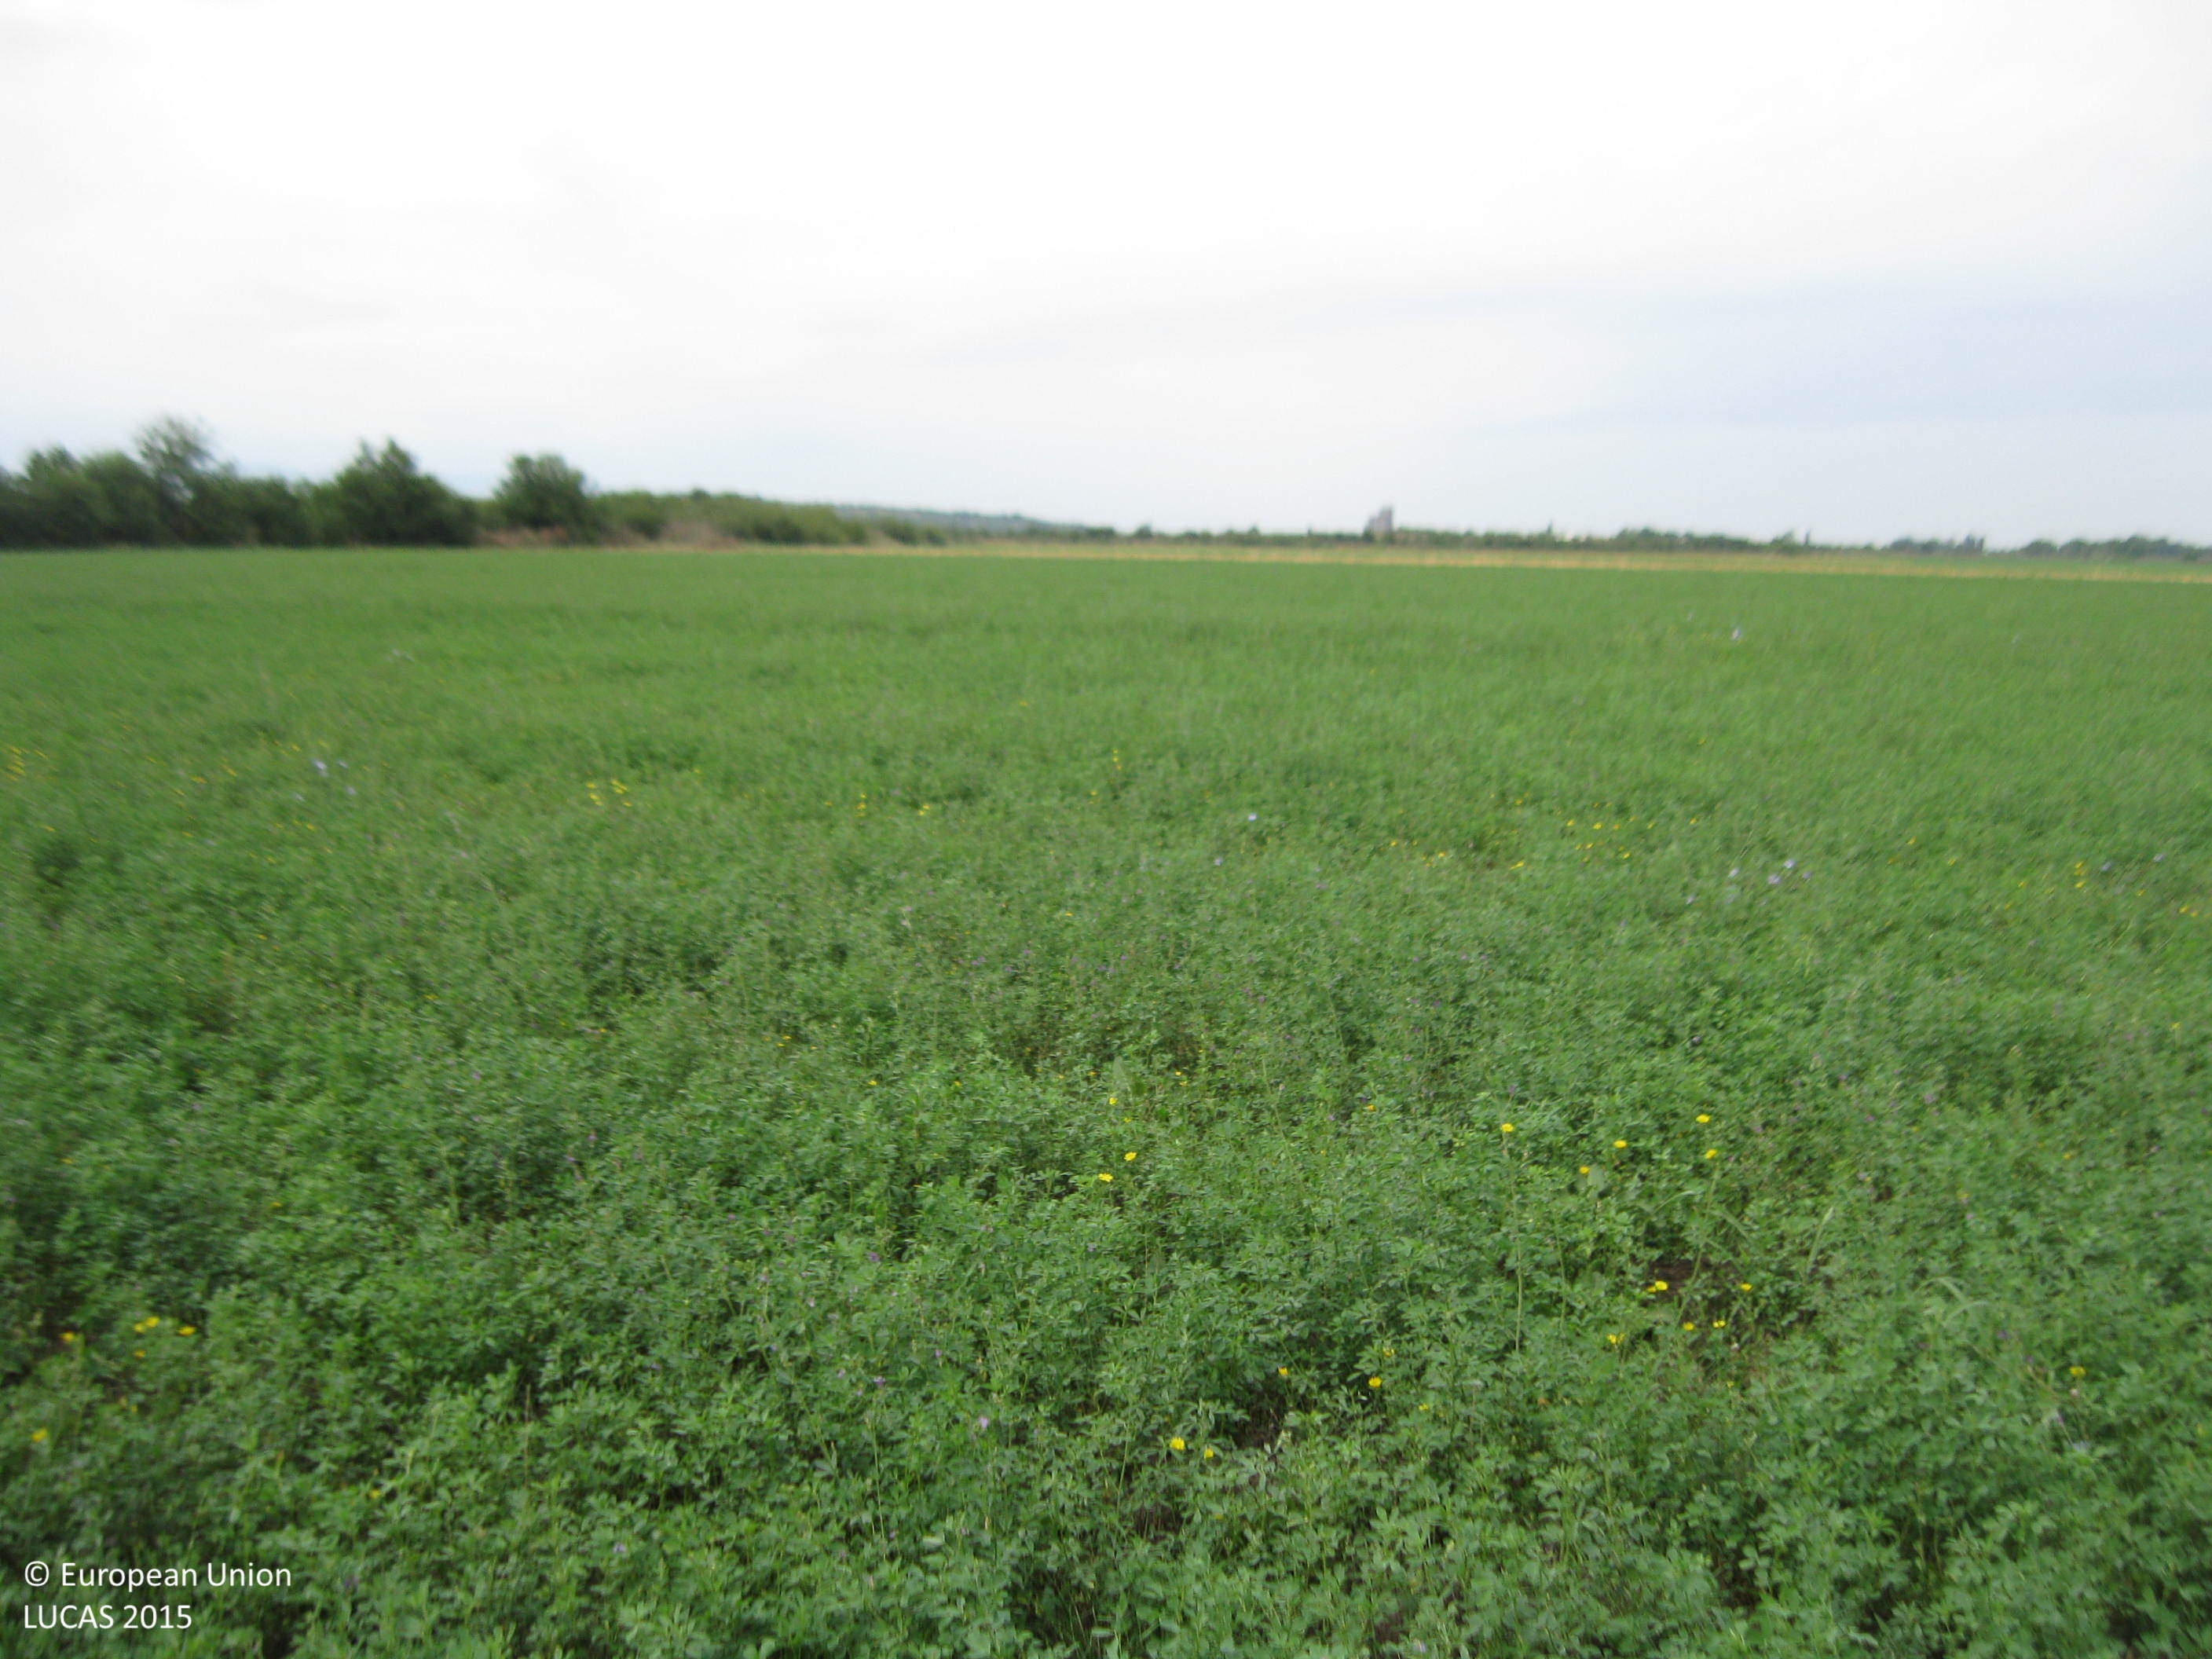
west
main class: Cropland
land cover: Lucerne
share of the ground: > 75 %
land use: Agriculture (excluding fallow land and kitchen gardens)
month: September
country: BG
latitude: 42.1385
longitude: 25.0969
